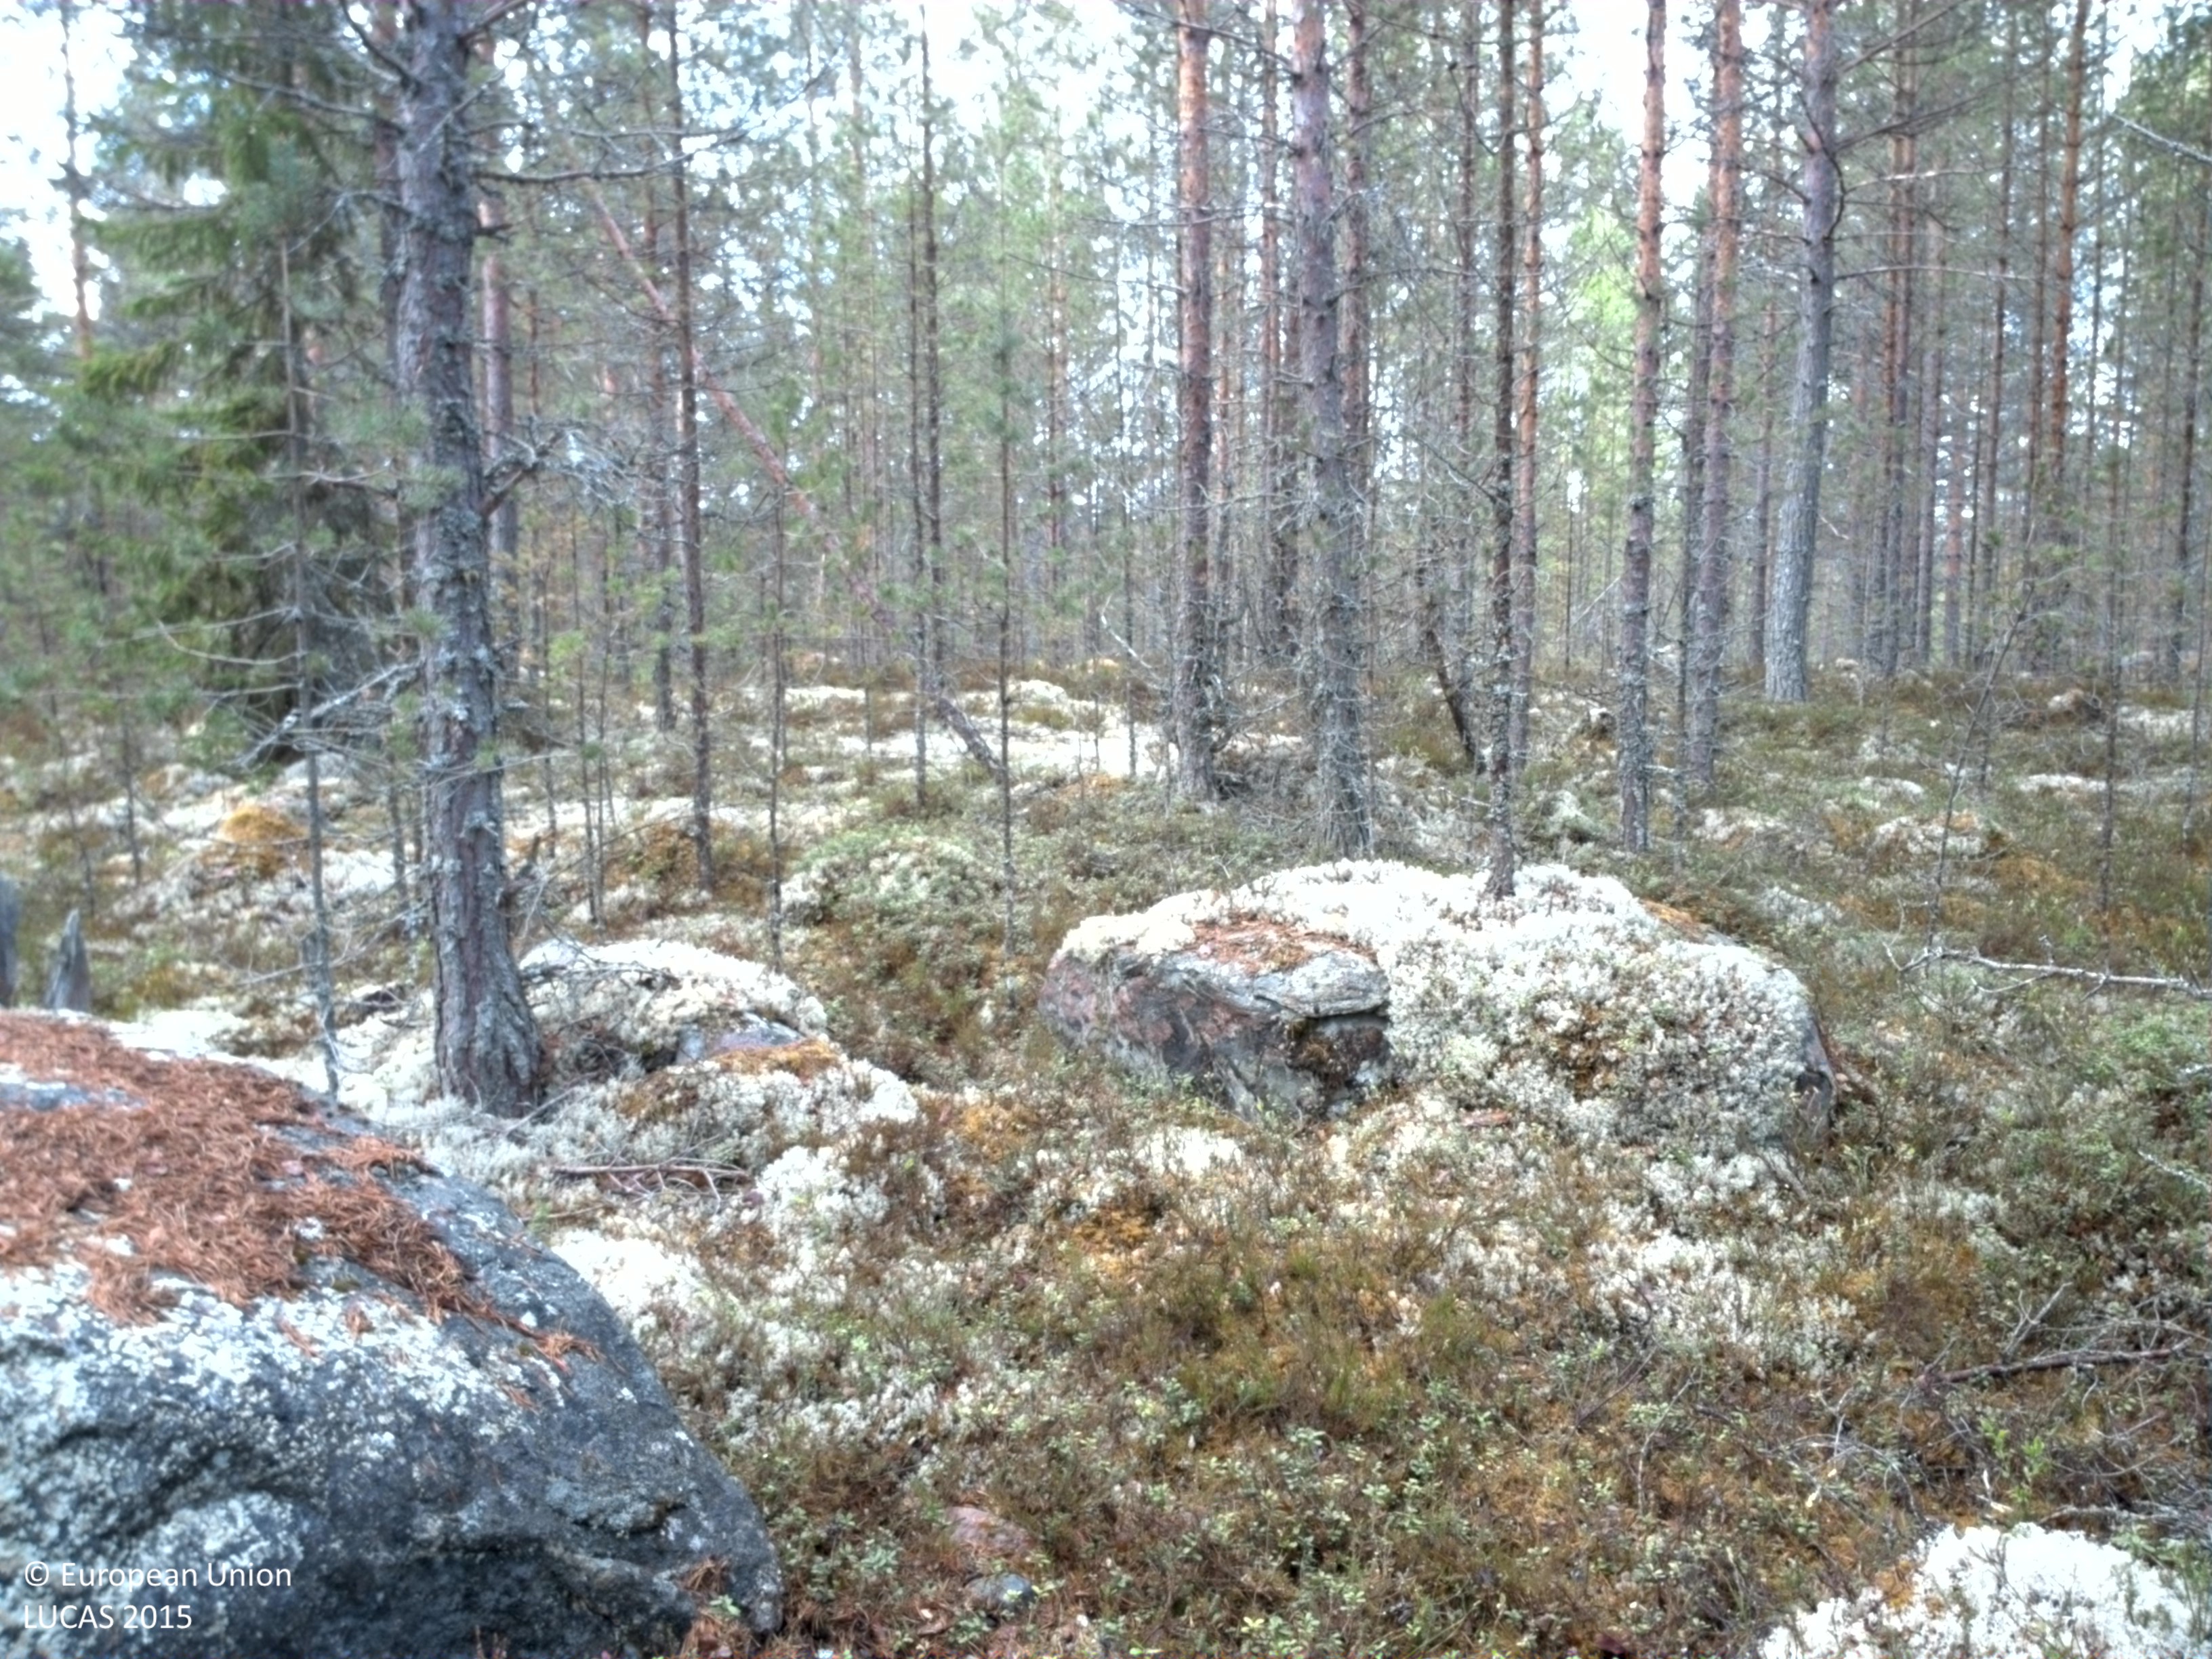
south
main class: Woodland
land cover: Pine dominated coniferous woodland
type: boreal forest
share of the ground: 50 - 75 %
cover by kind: coniferous forest trees 65 %, herbaceous plants 30 %, lichens and mosses 5 %
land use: Forestry
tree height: > 5 m
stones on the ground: < 10 %
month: May
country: SE
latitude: 61.2132
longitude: 15.4395
